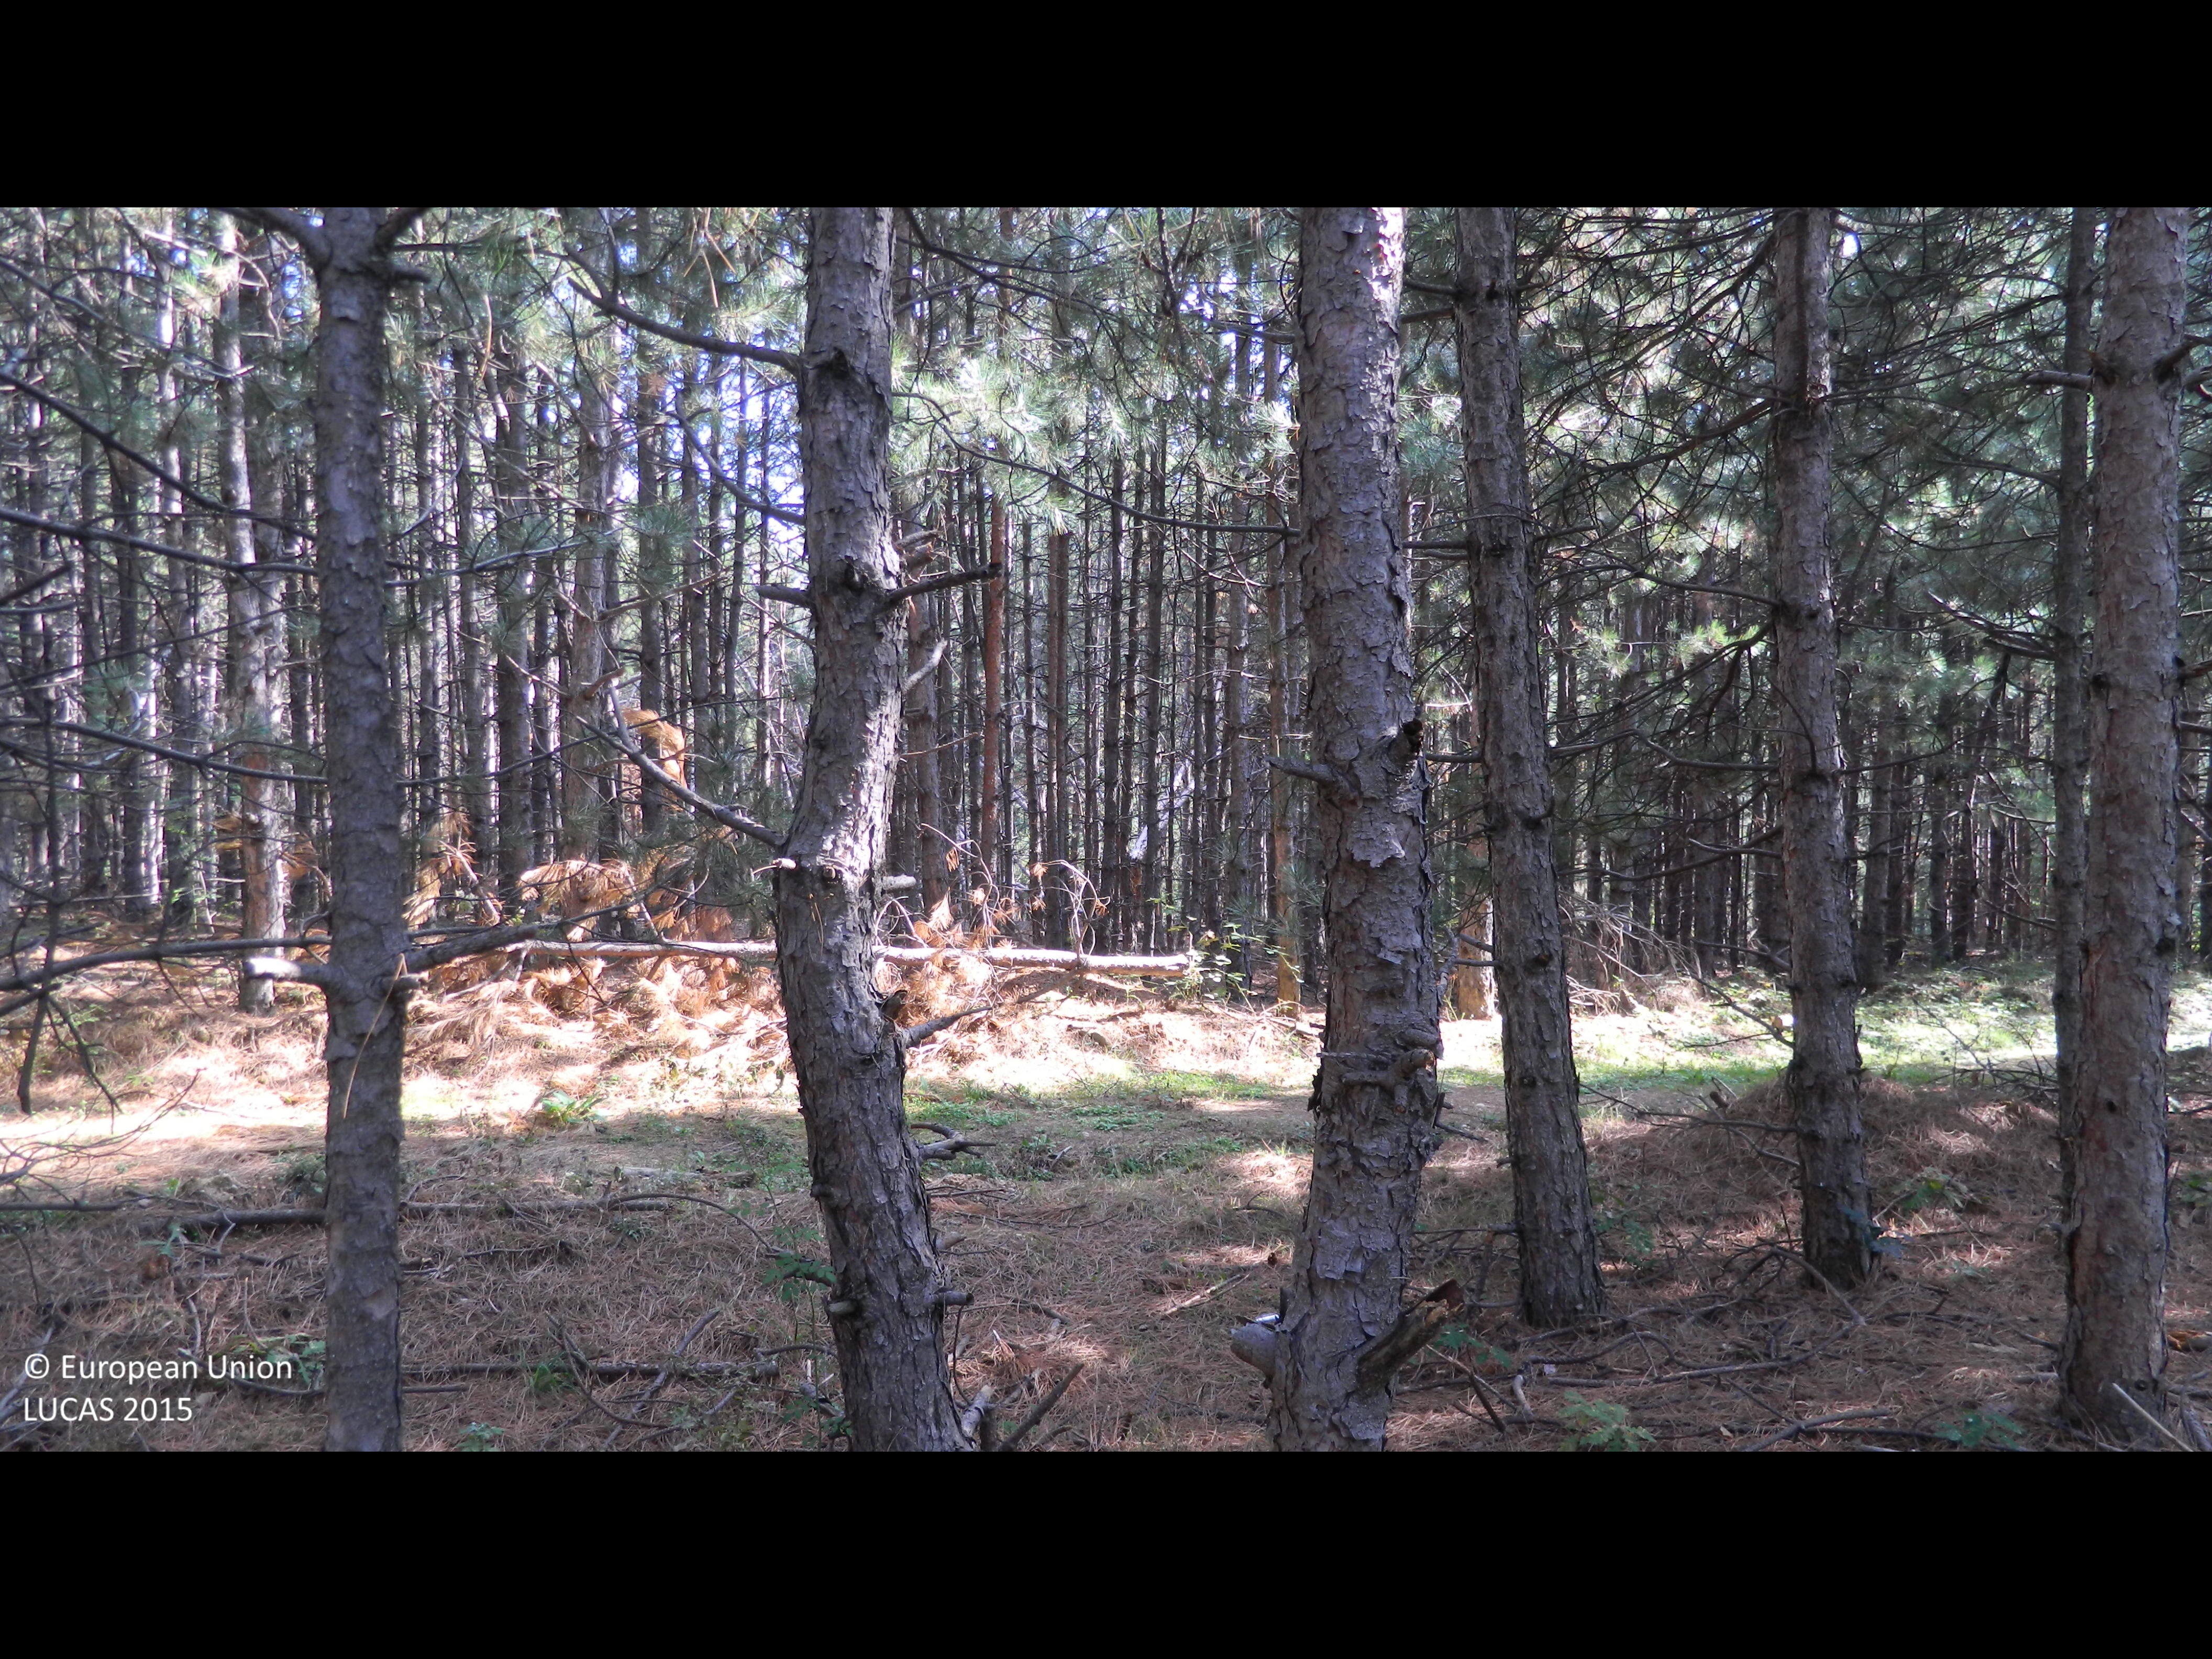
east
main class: Woodland
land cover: Pine dominated coniferous woodland
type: hemiboreal forest and nemoral coniferous forest and mixed broadleaved-coniferous forest
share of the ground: > 75 %
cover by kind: coniferous forest trees 95 %, broadleaved forest trees 5 %
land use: Forestry
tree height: > 5 m
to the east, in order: Pine dominated coniferous woodland; Tracks; Pine dominated coniferous woodland; Grassland without tree/shrub cover; Pine dominated coniferous woodland; Pine dominated mixed woodland; Rivers and streams; Broadleaved woodland
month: October
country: BG
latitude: 41.7948
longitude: 25.3049
